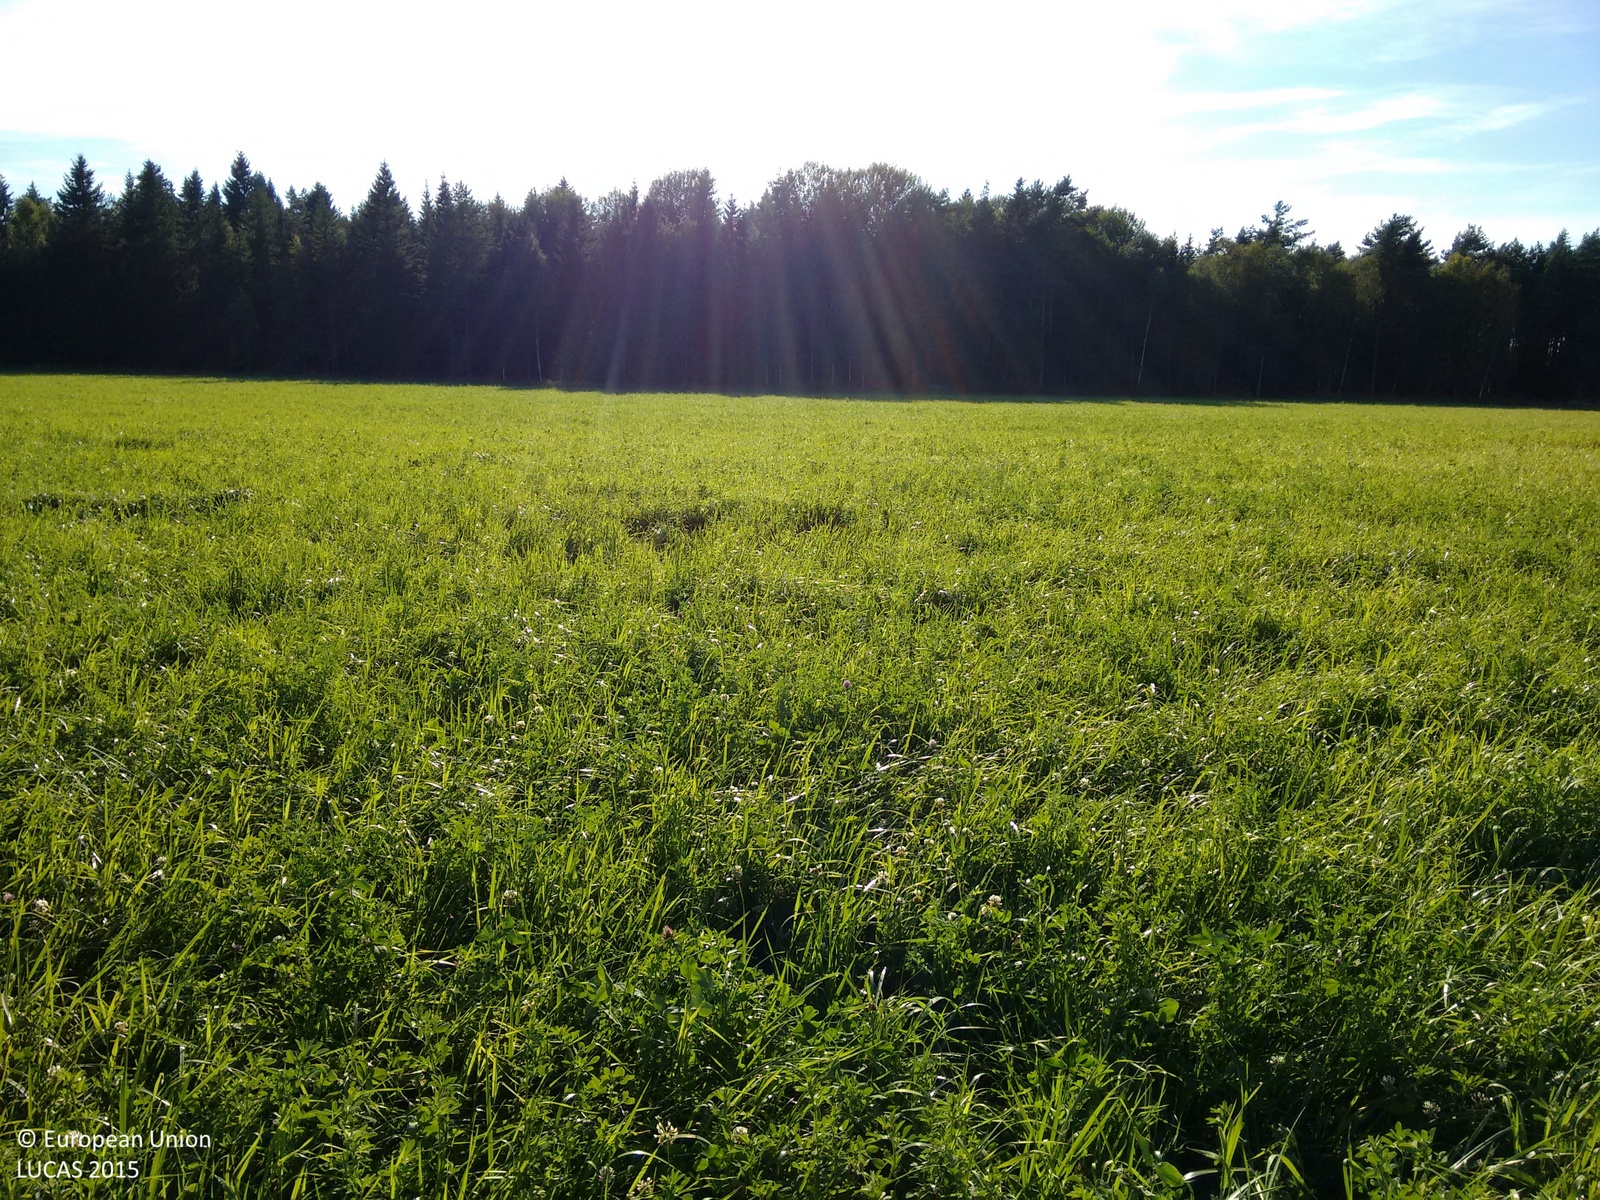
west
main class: Cropland
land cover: Temporary grasslands
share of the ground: > 75 %
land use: Agriculture (excluding fallow land and kitchen gardens)
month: August
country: FI
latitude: 60.1944
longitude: 19.9079
